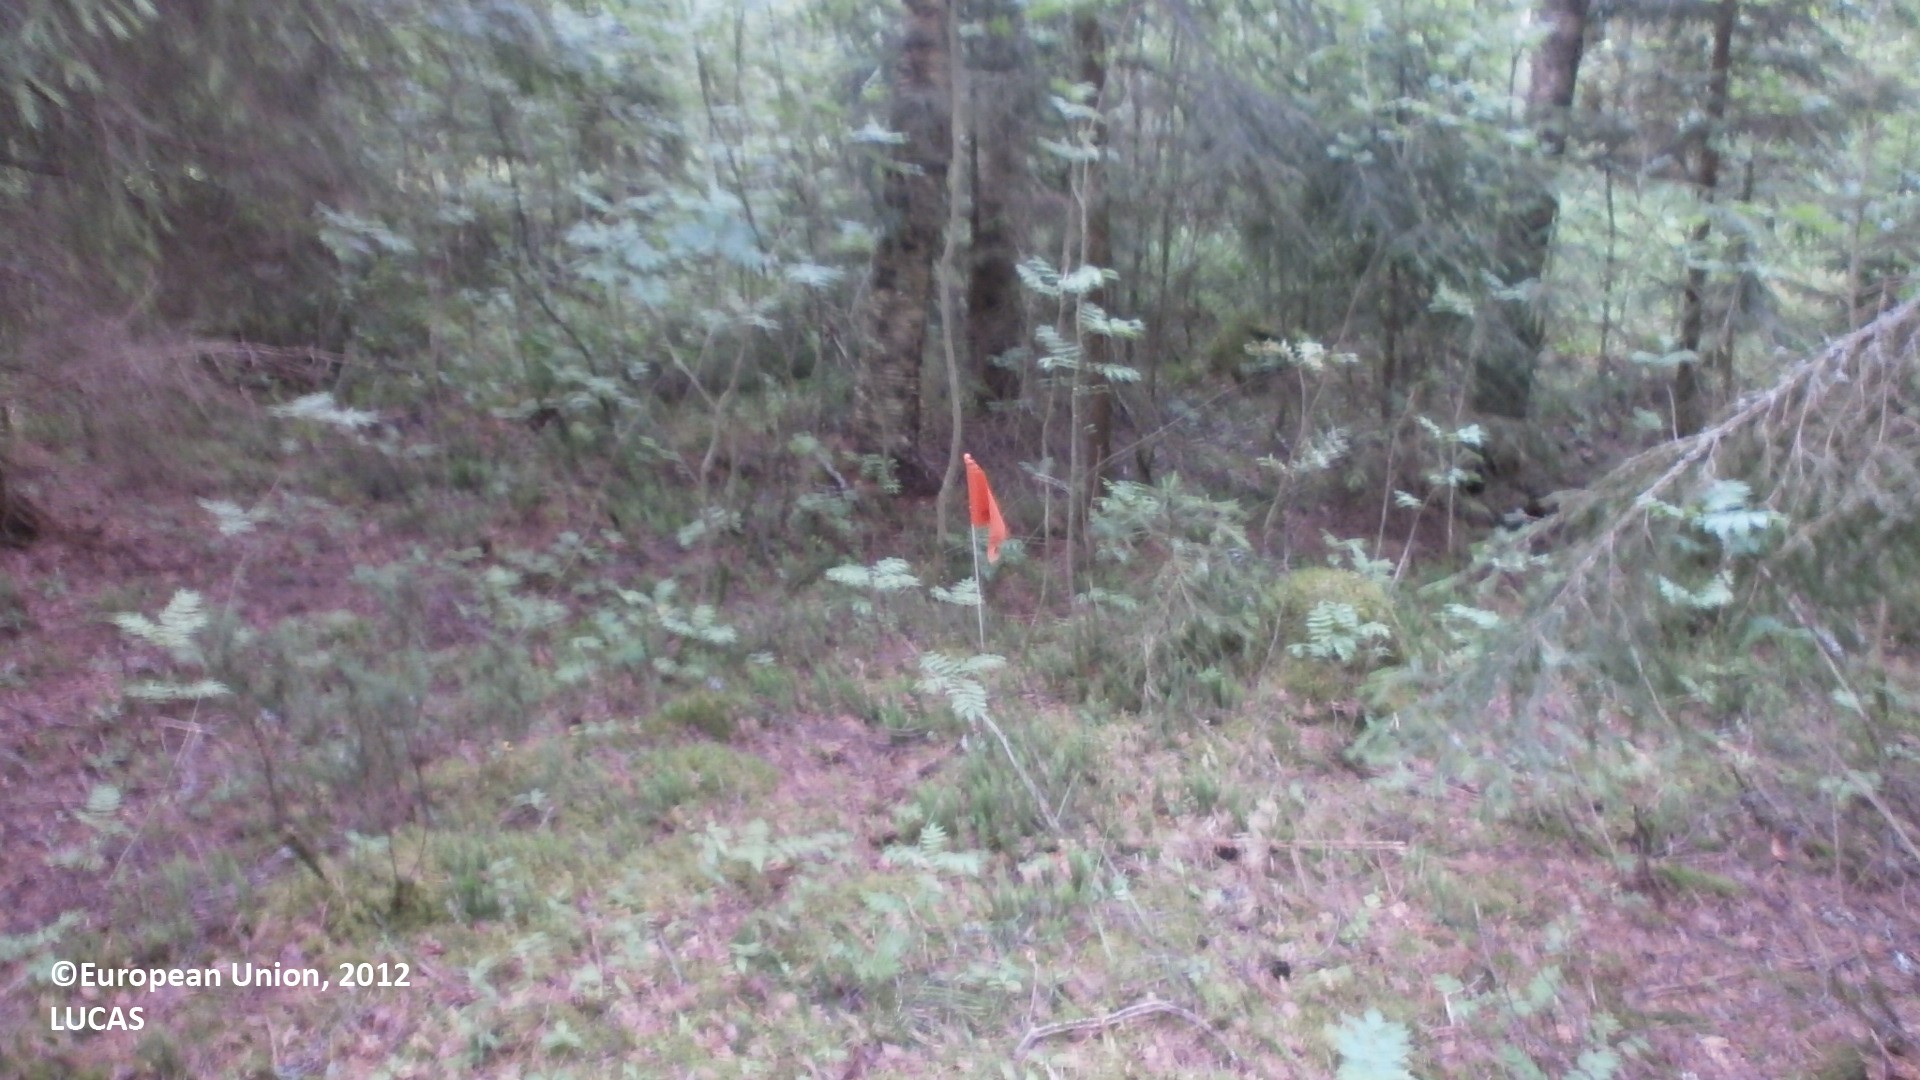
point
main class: Woodland
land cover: Spruce dominated mixed woodland
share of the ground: > 75 %
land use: Forestry
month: July
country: FI
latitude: 64.3046
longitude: 24.4365
